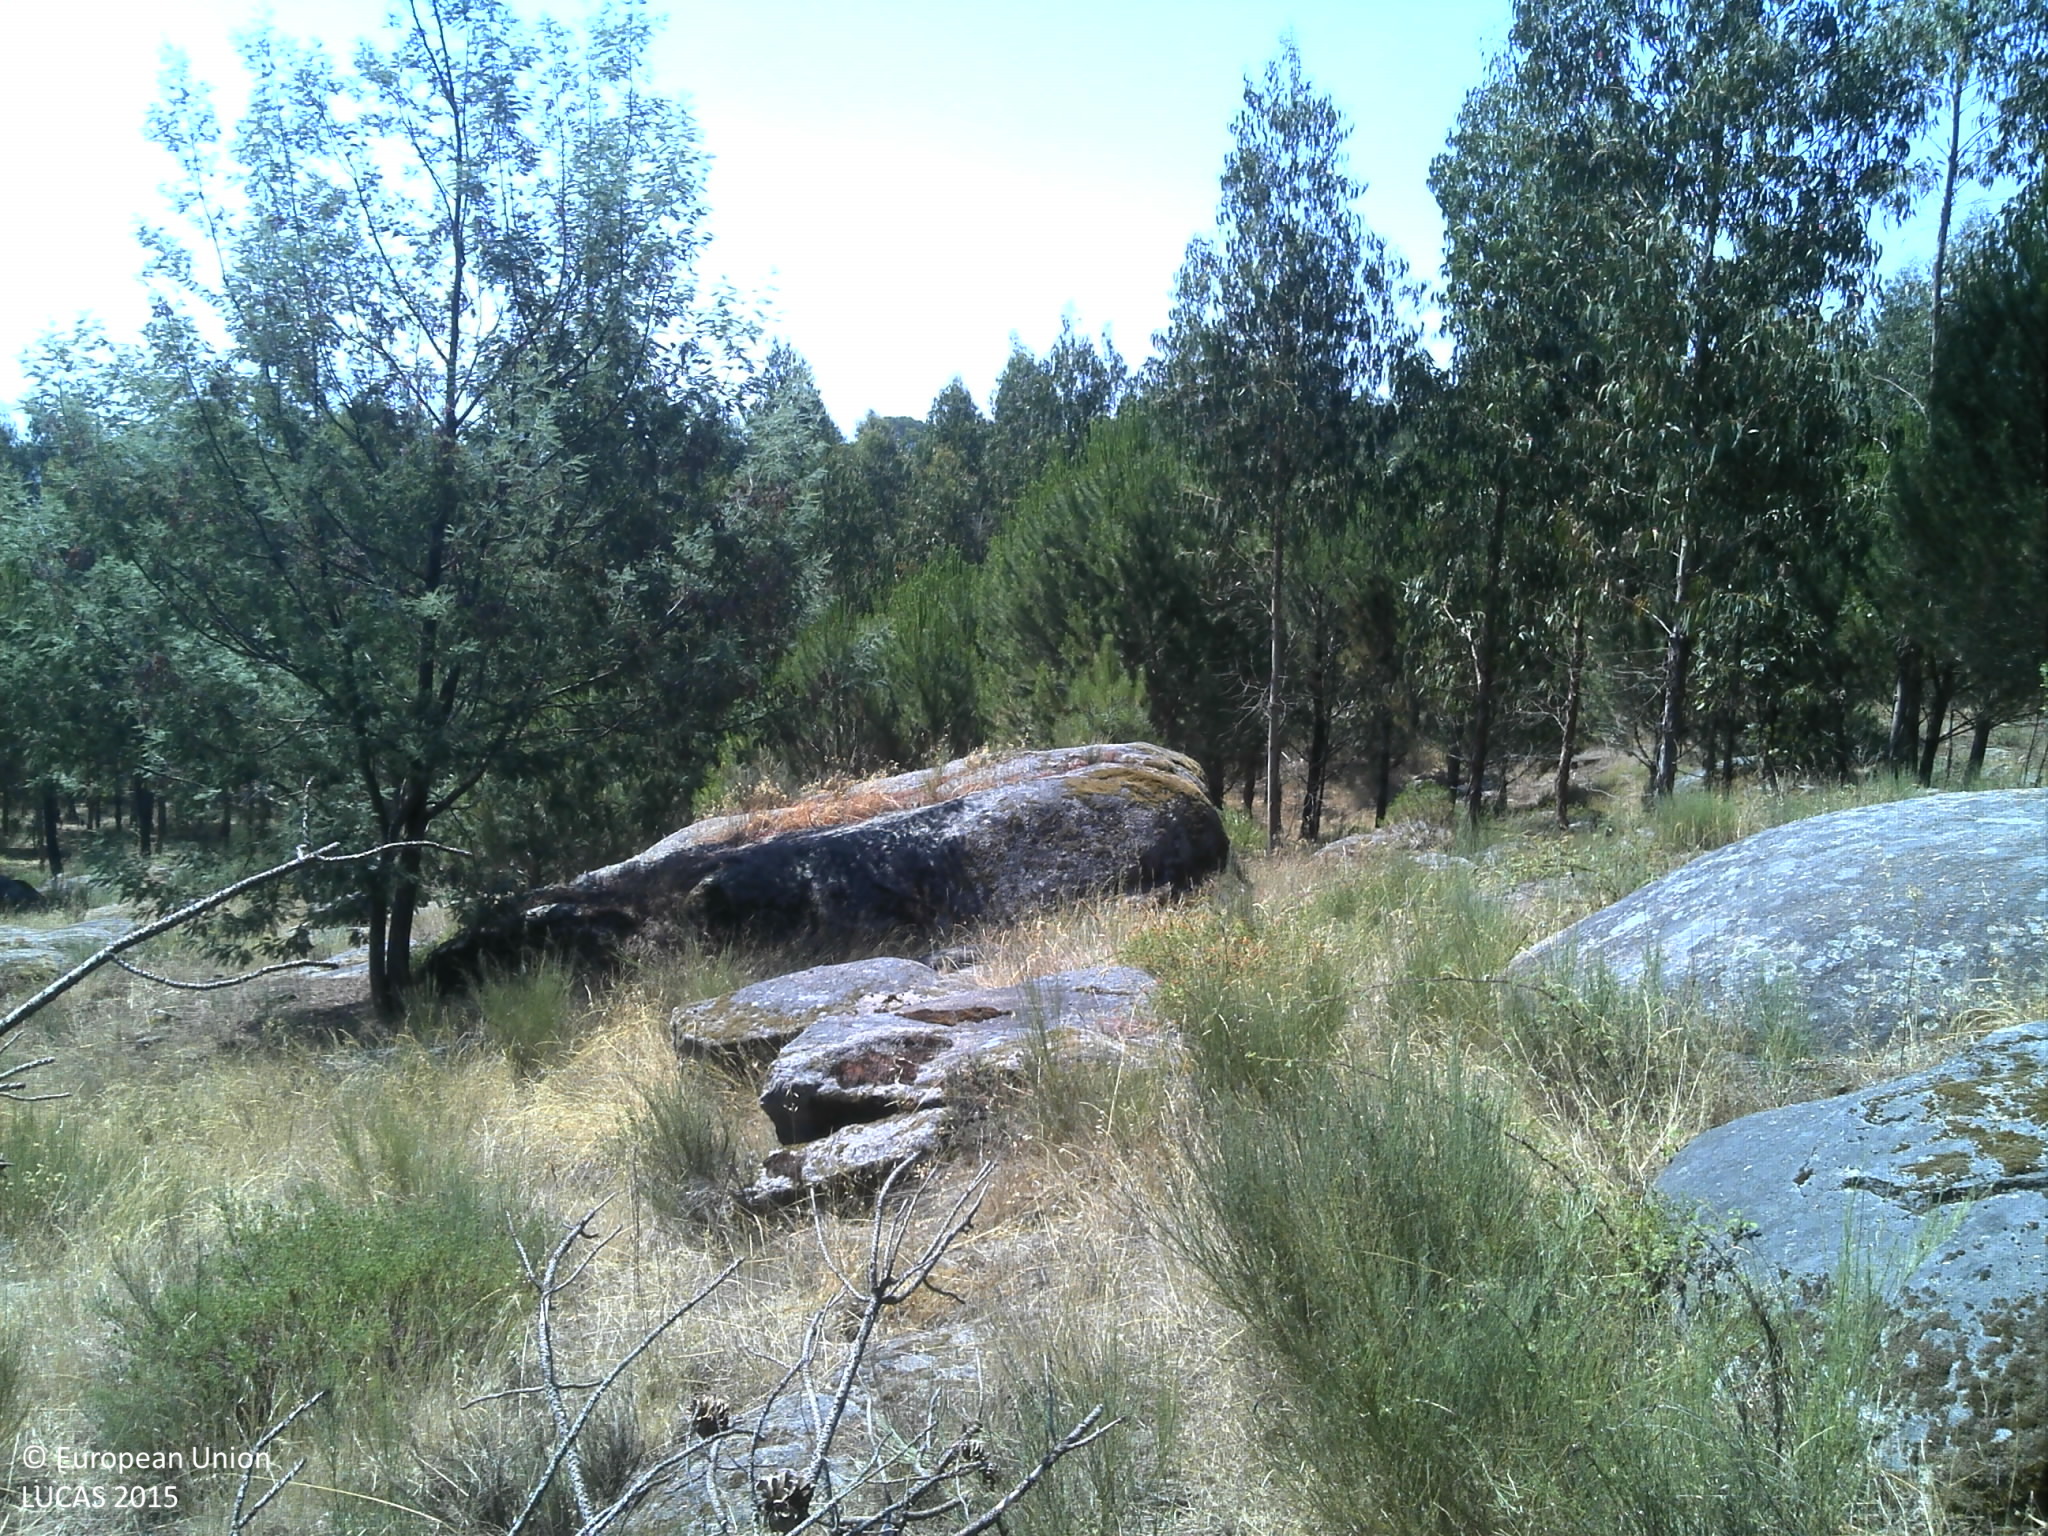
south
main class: Woodland
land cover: Pine dominated coniferous woodland
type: coniferous forest of the mediterranean region
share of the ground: 25 - 50 %
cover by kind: coniferous forest trees 45 %, herbaceous plants 25 %, shrubs 10 %, consolidated bare surface 10 %, unconsolidated bare surface 10 %
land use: Forestry
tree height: > 5 m
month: June
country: PT
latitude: 40.5329
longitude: -7.7677
